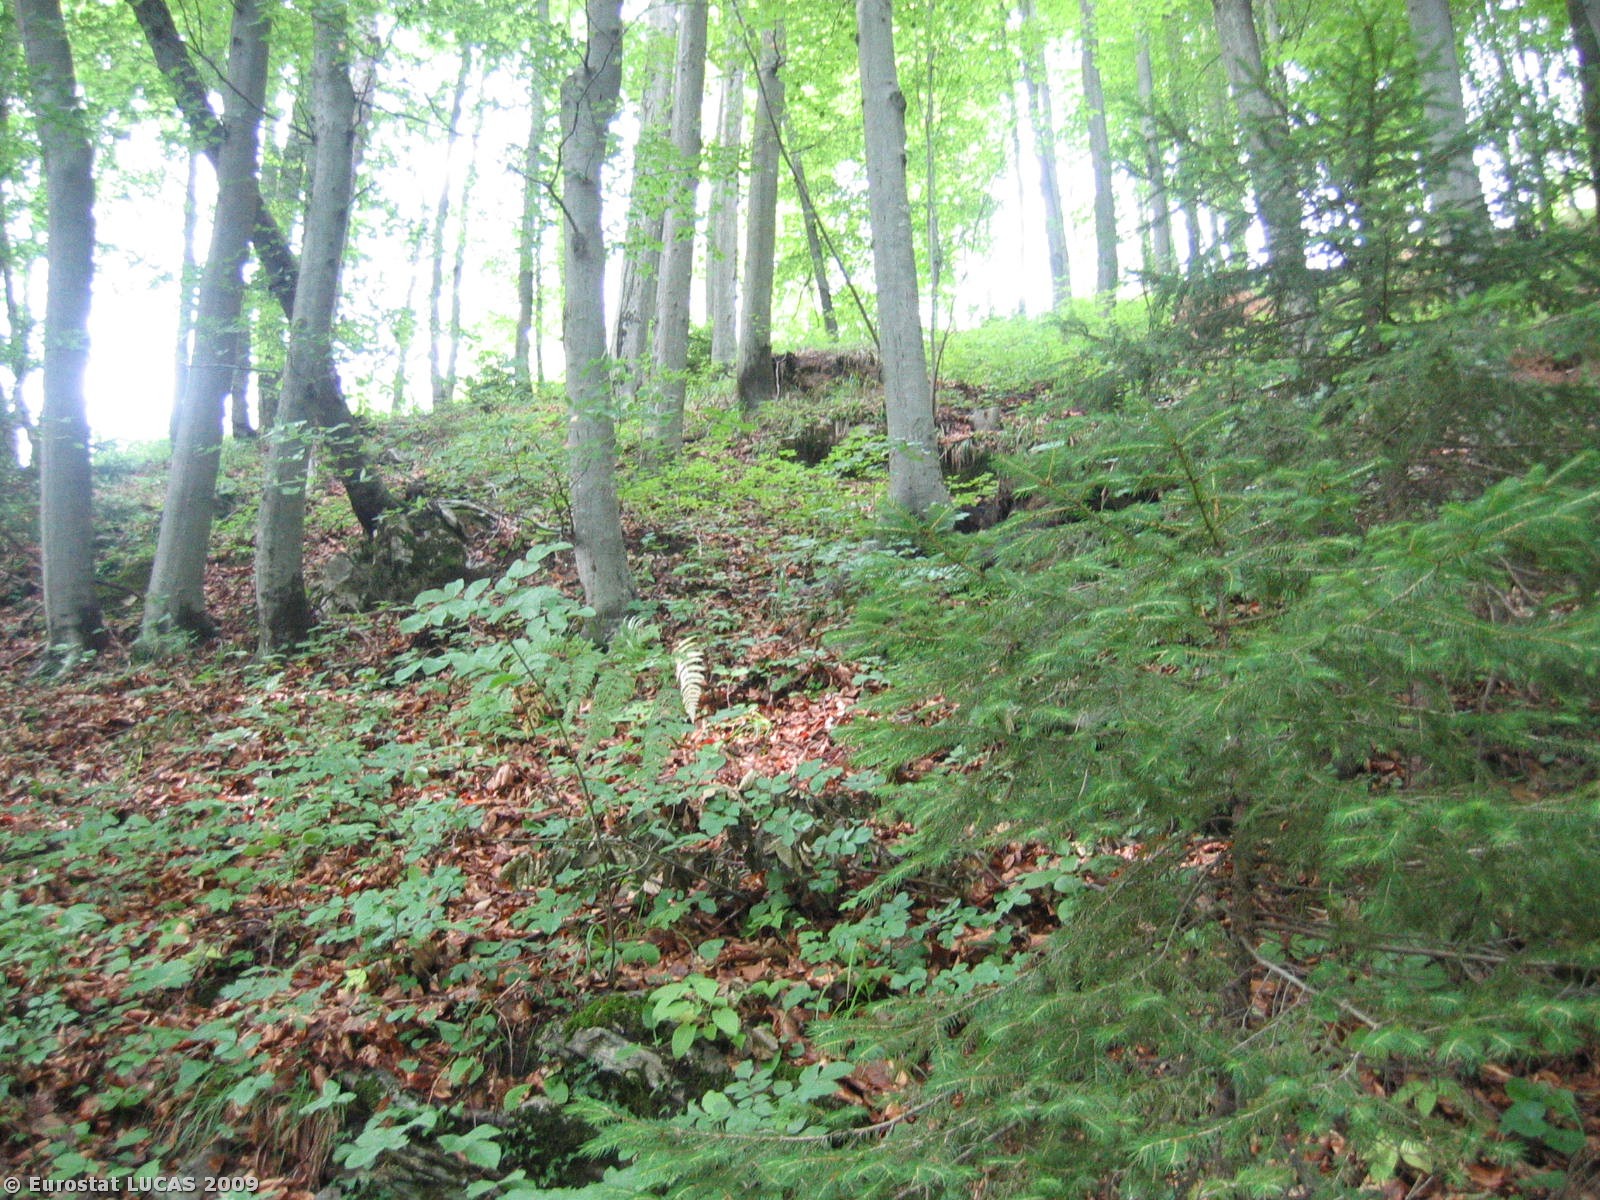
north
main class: Woodland
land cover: Broadleaved woodland
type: mountainous beech forest
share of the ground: > 75 %
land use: Forestry
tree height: > 5 m
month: June
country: SI
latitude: 46.2312
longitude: 14.2368
